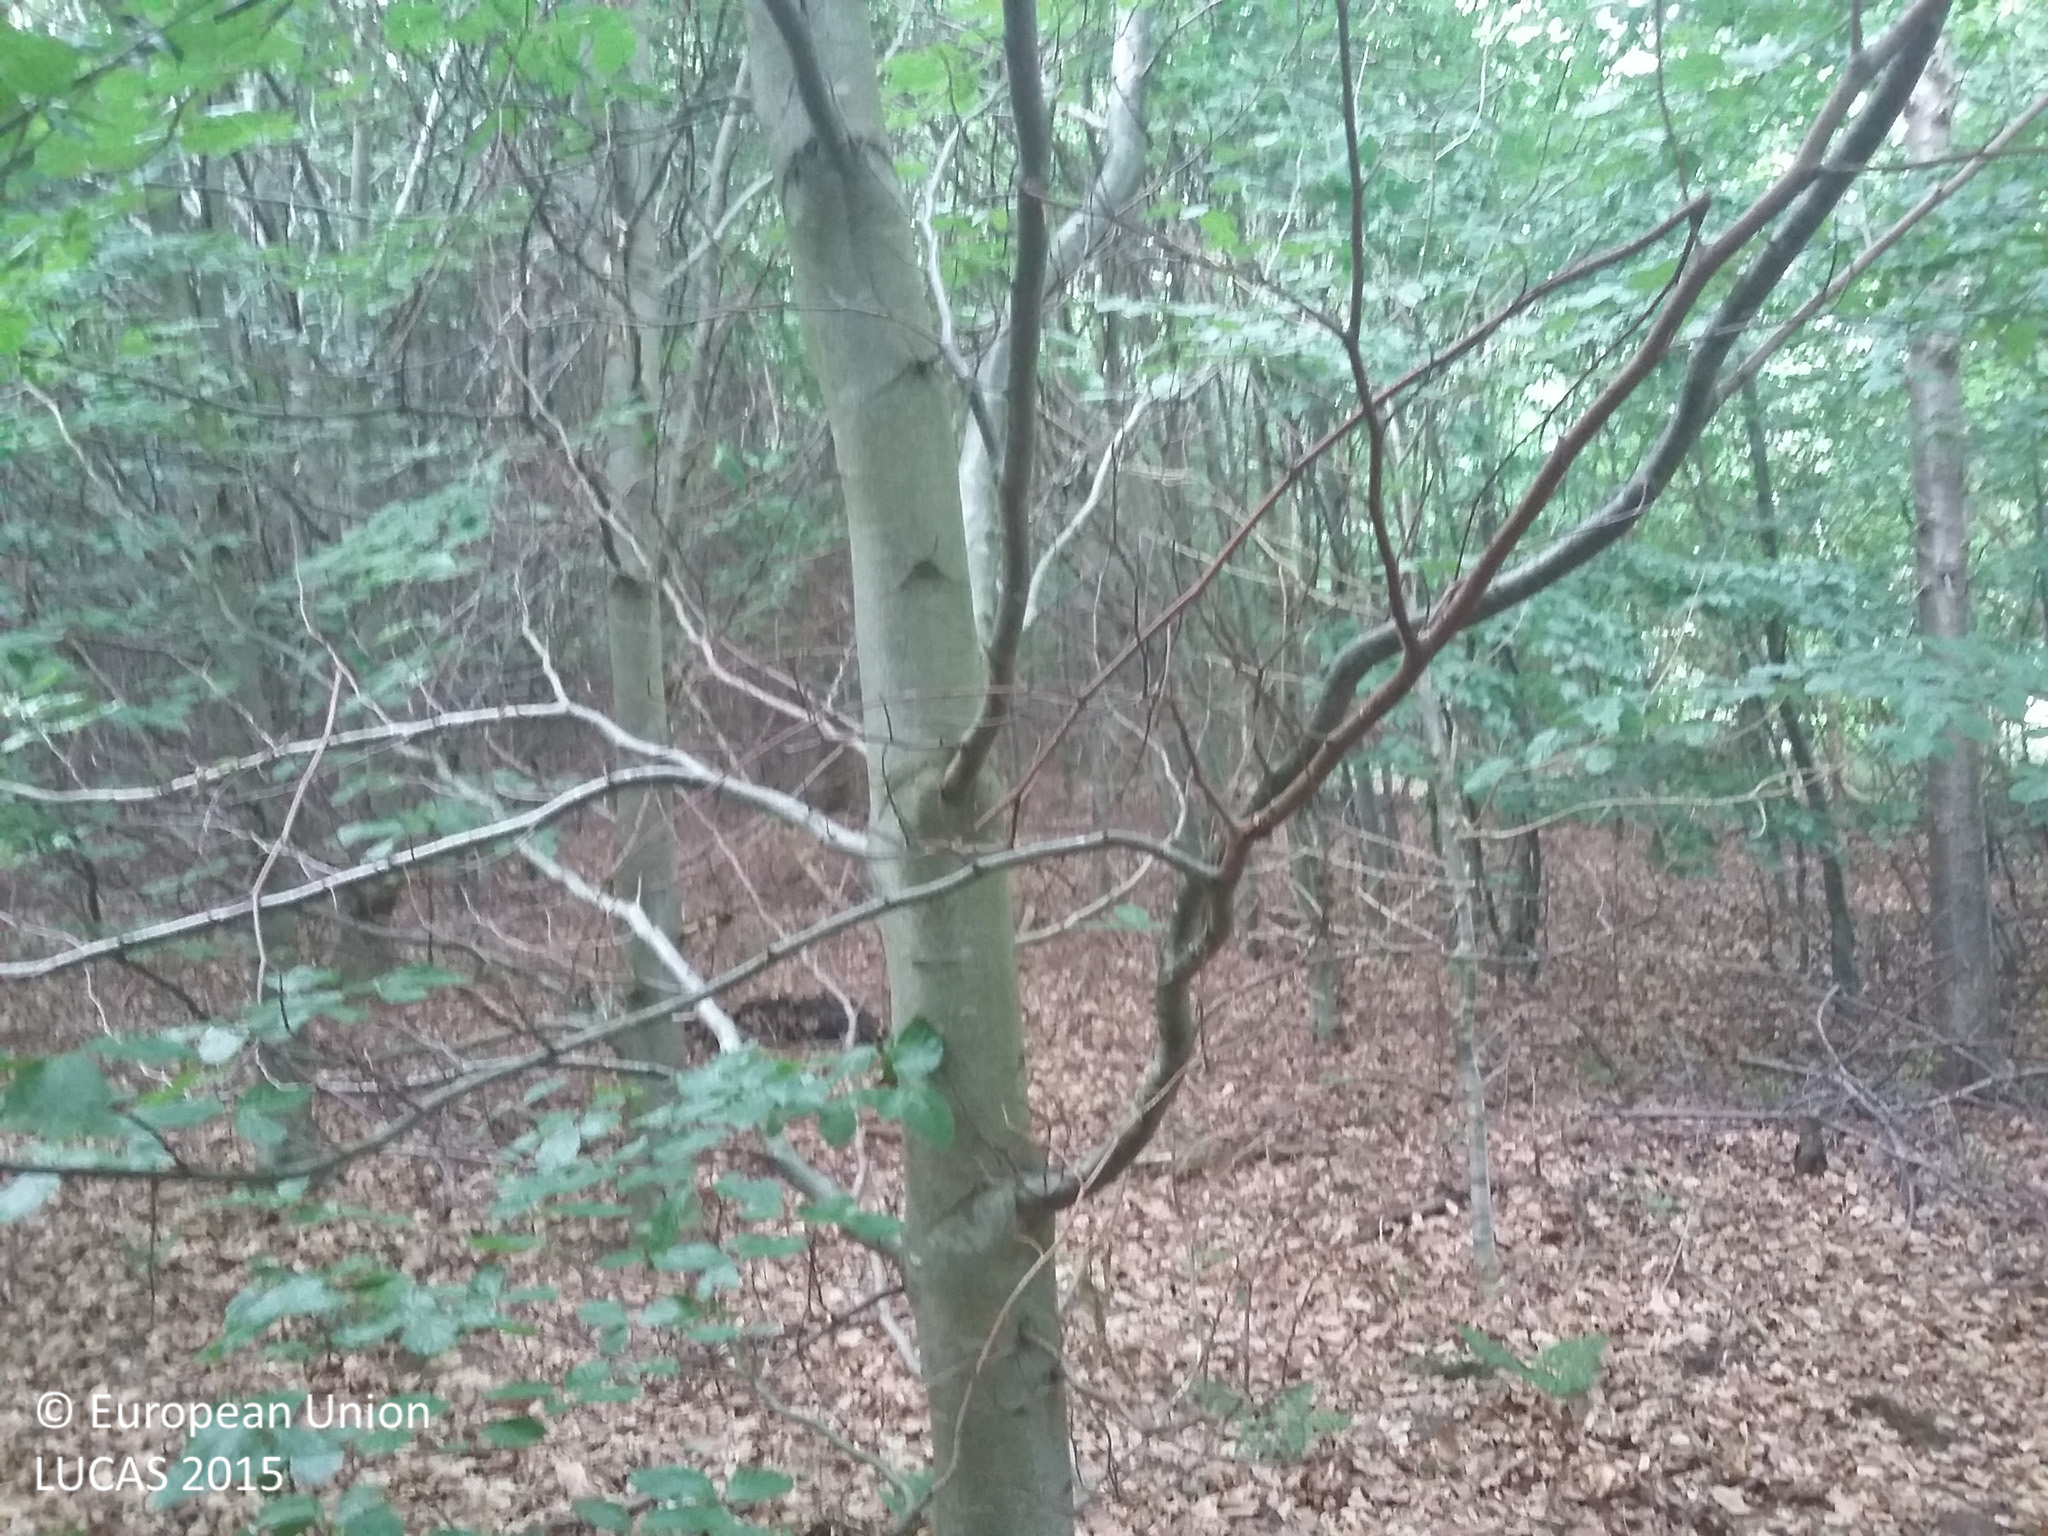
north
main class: Woodland
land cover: Broadleaved woodland
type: beech forest
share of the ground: > 75 %
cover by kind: broadleaved forest trees 95 %, unconsolidated bare surface 5 %
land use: Forestry
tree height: > 5 m
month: July
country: DK
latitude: 55.7398
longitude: 12.0528
